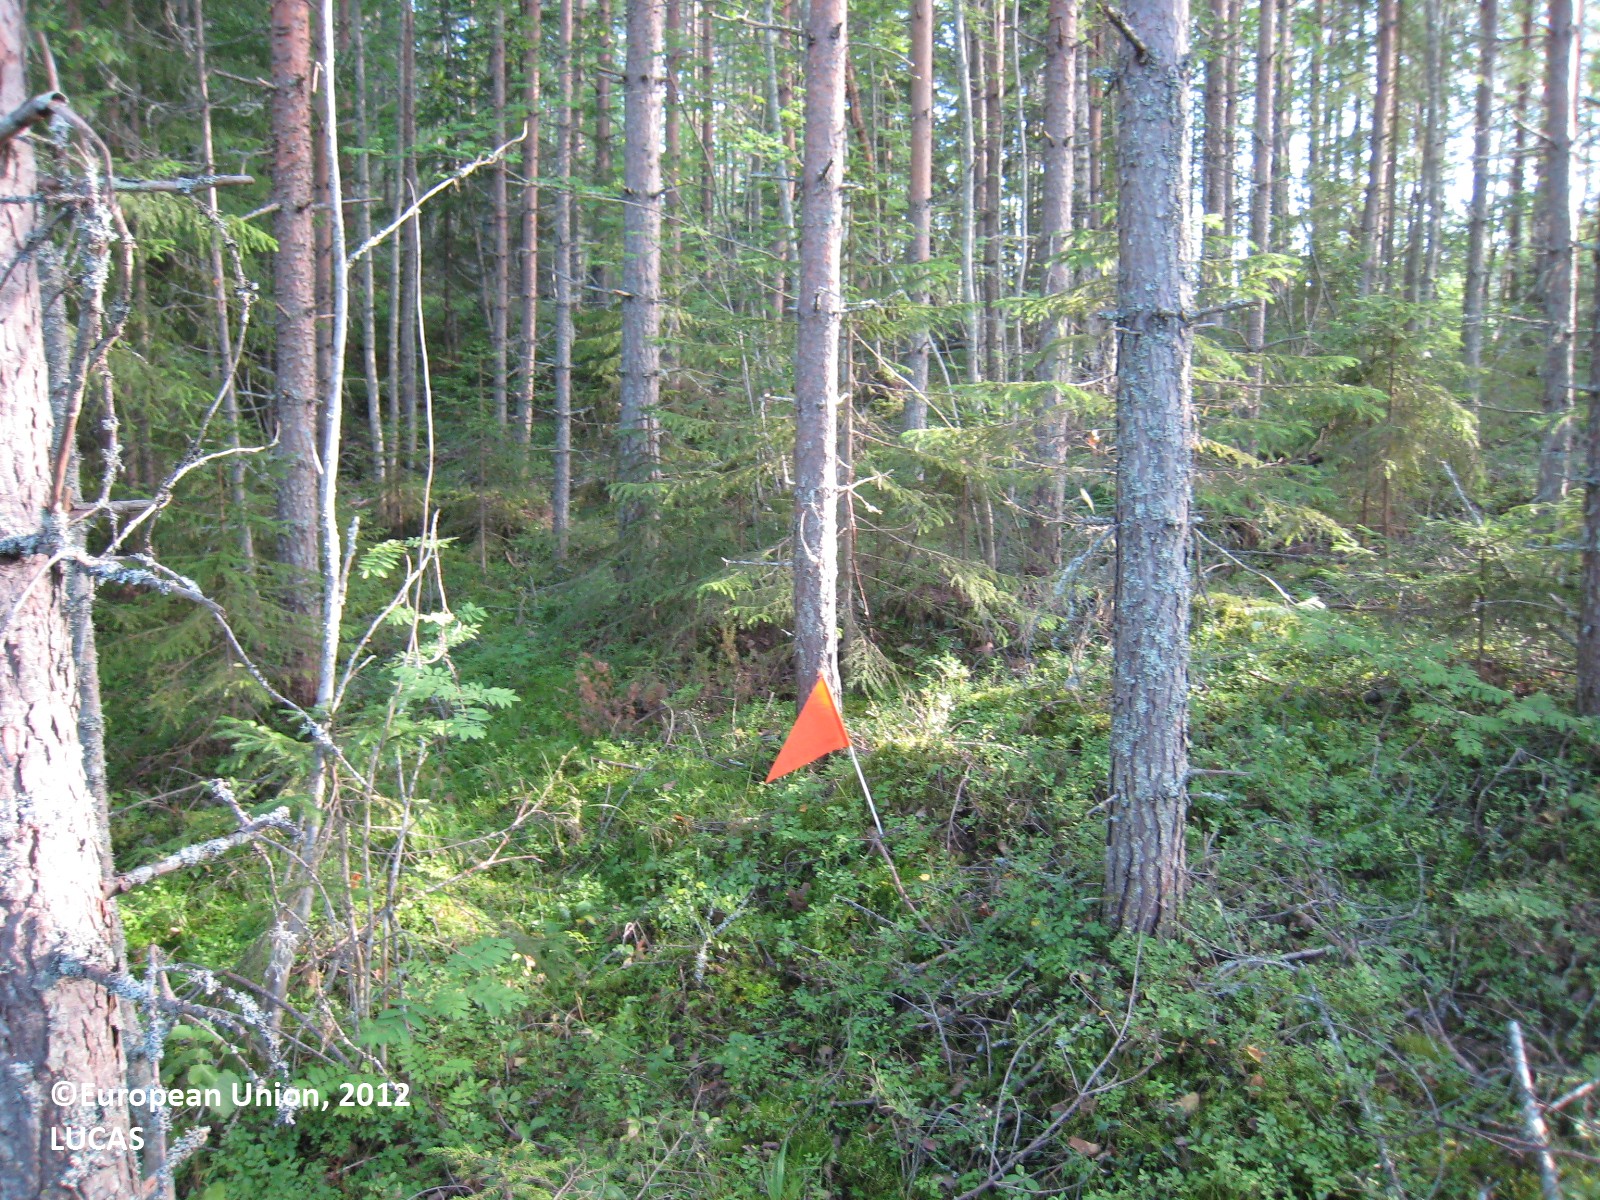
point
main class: Woodland
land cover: Pine dominated mixed woodland
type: boreal forest
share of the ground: > 75 %
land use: Forestry
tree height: > 5 m
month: July
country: FI
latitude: 62.8500
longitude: 26.7389
